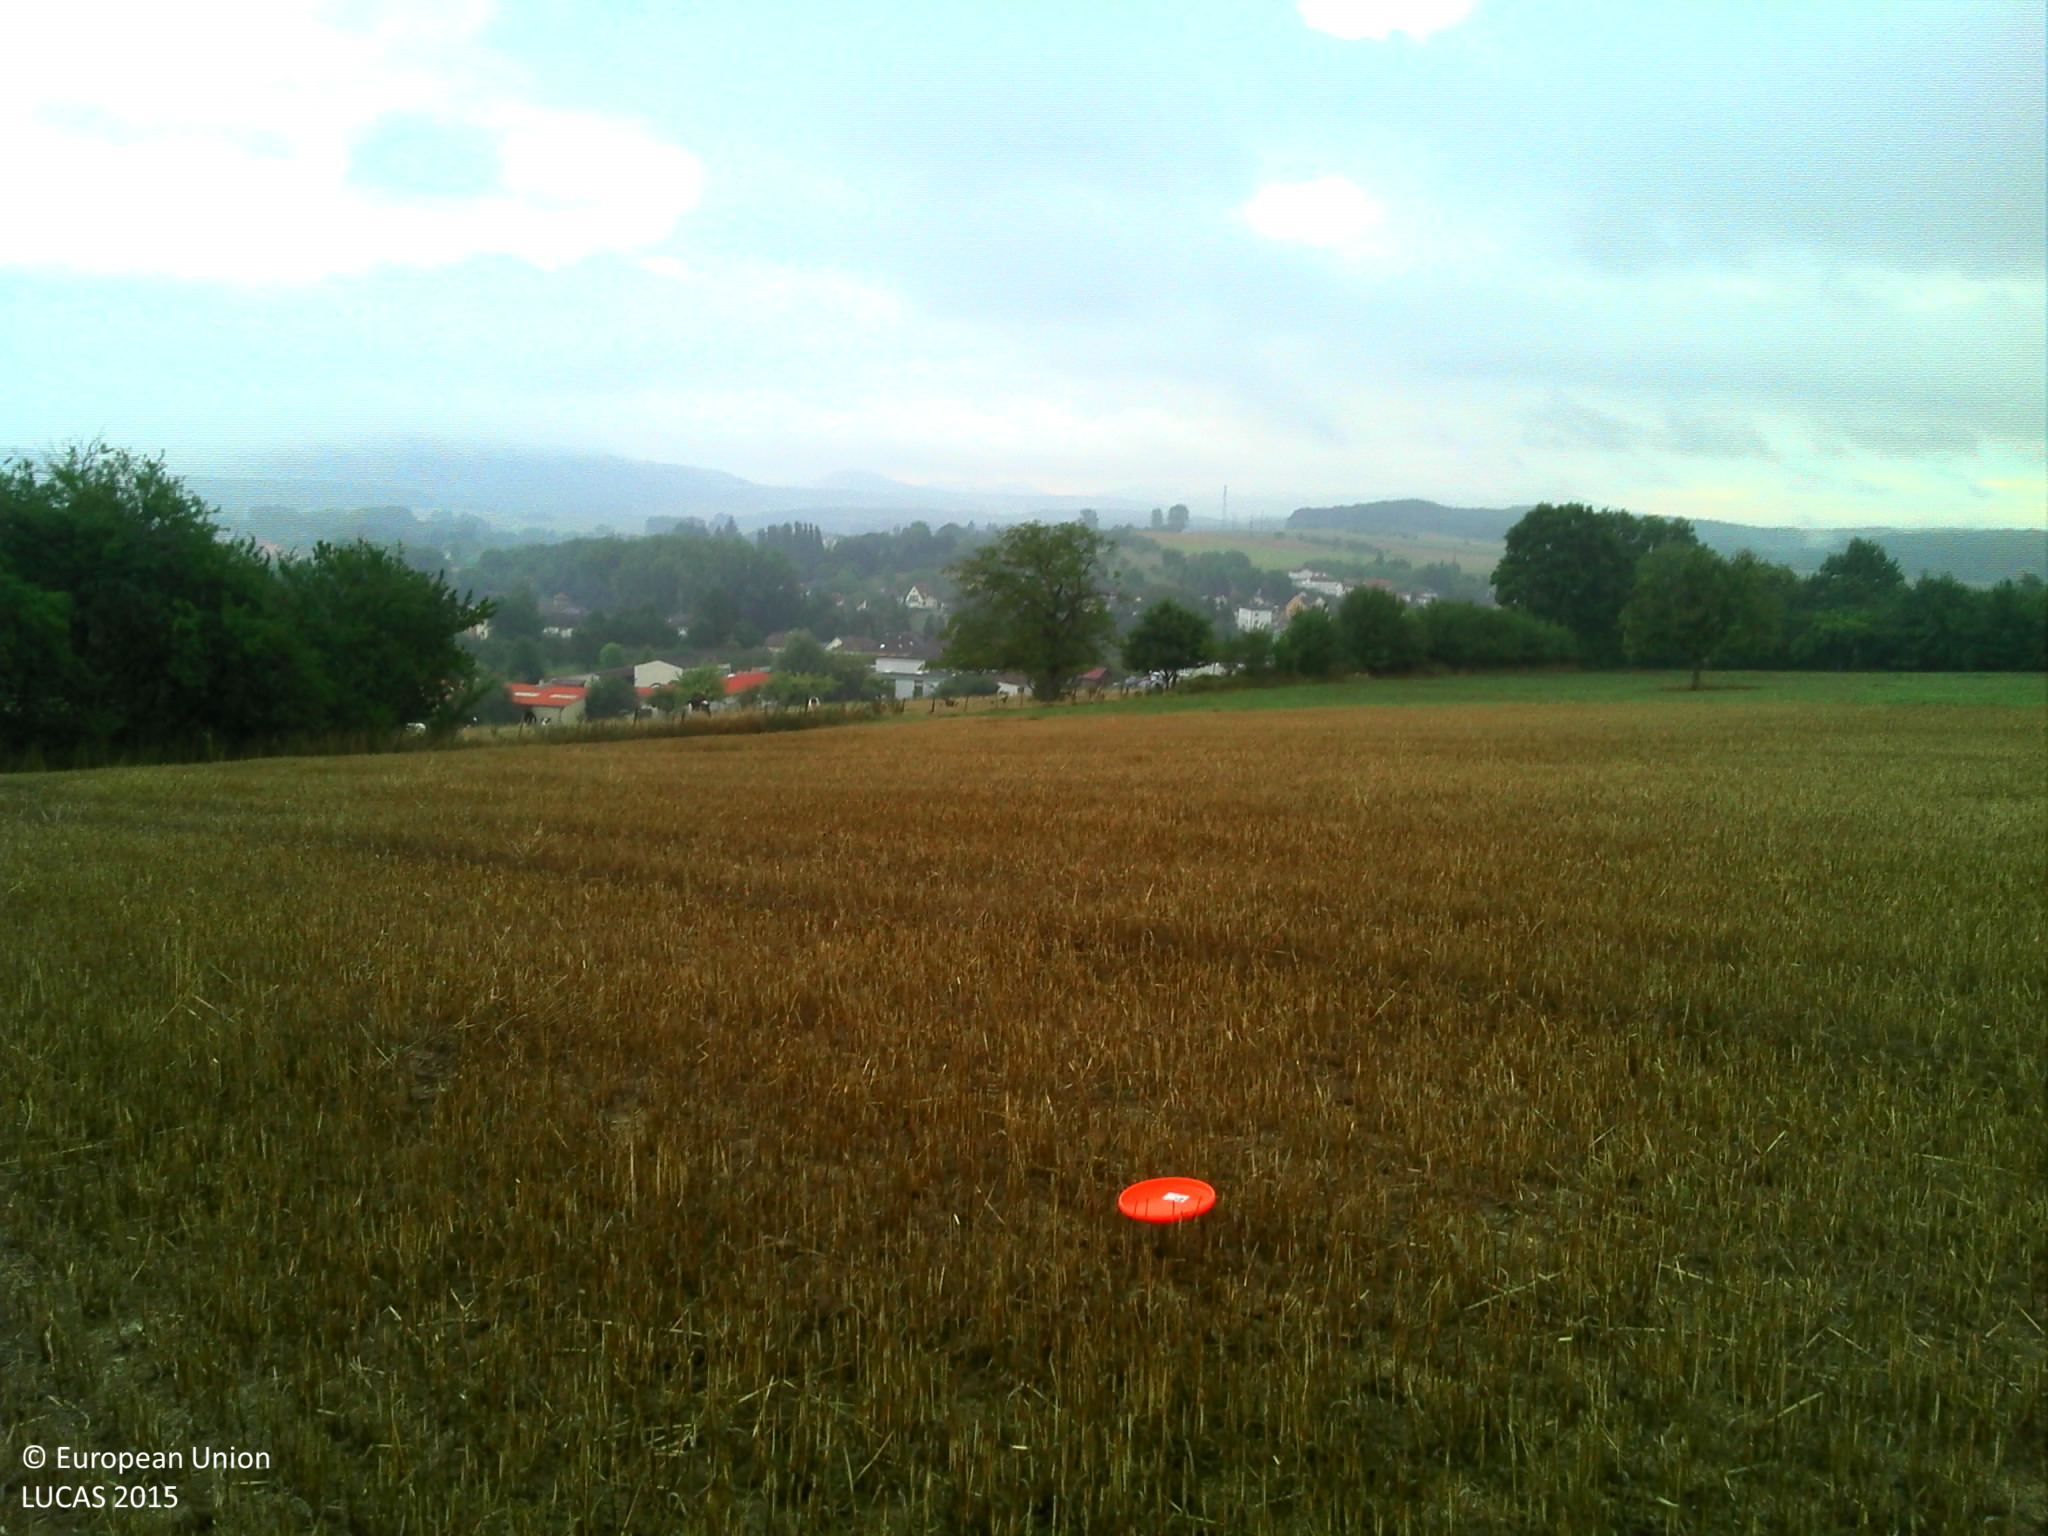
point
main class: Cropland
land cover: Triticale
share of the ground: 50 - 75 %
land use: Agriculture (excluding fallow land and kitchen gardens)
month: August
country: FR
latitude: 48.8608
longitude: 7.4790
